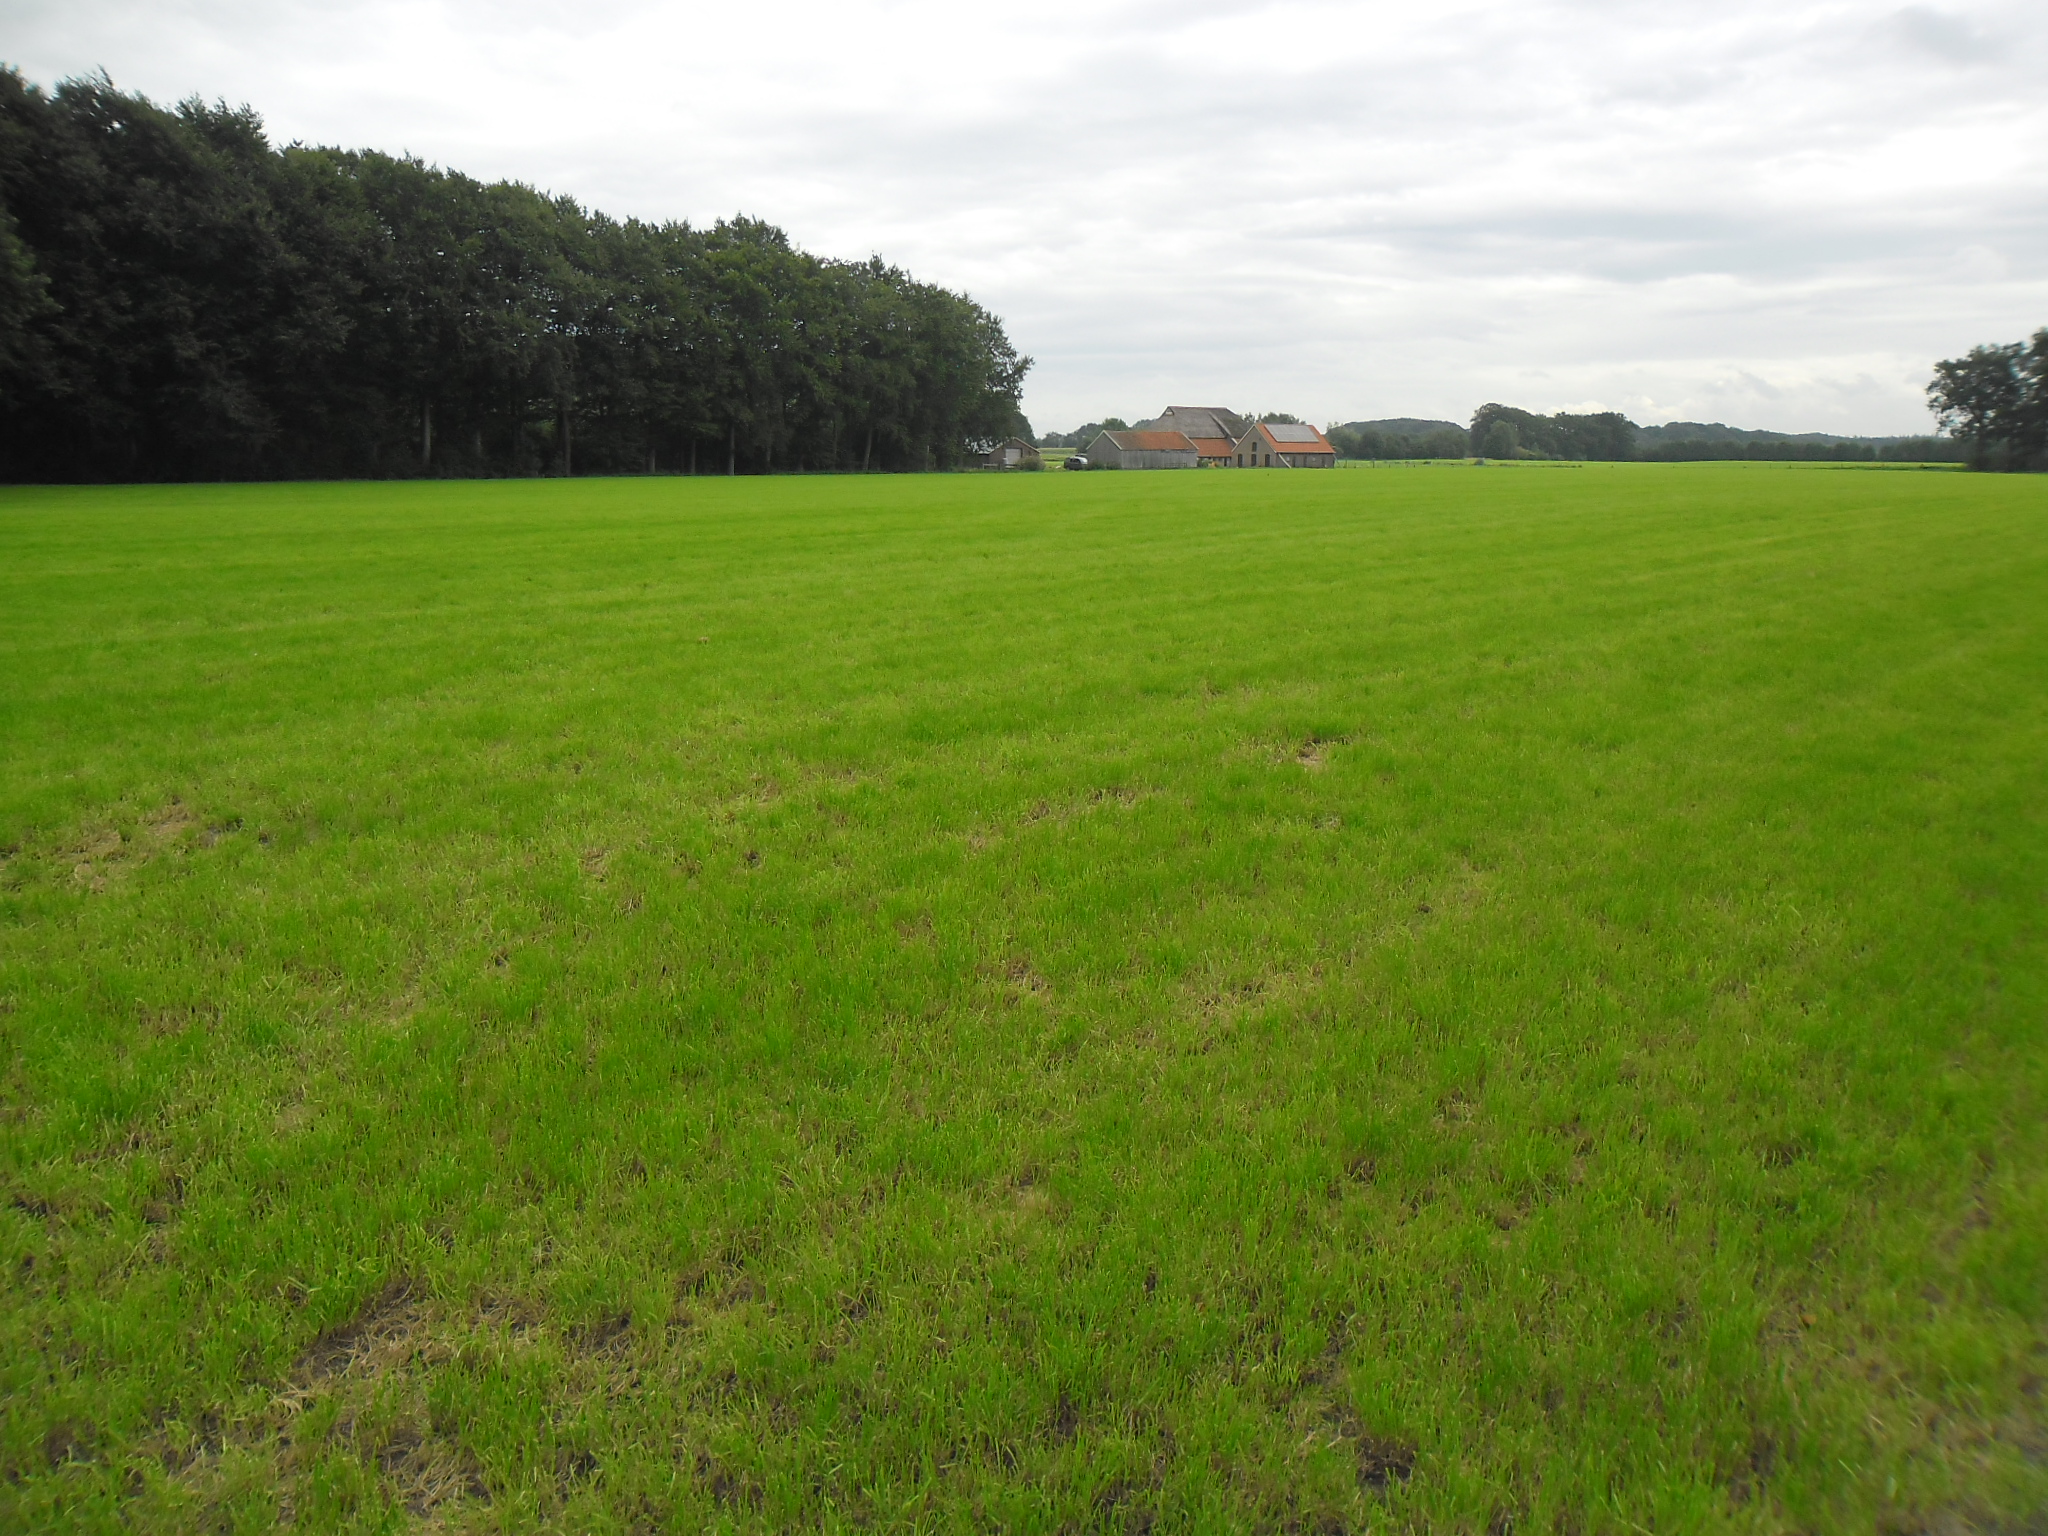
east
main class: Grassland
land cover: Grassland without tree/shrub cover
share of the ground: > 75 %
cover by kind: herbaceous plants 100 %
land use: Agriculture (excluding fallow land and kitchen gardens)
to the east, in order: Grassland without tree/shrub cover; Fences; Ditches and canals; Lines of trees; Tracks; Lines of trees; Broadleaved woodland
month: September
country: NL
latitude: 52.1570
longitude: 6.2721
